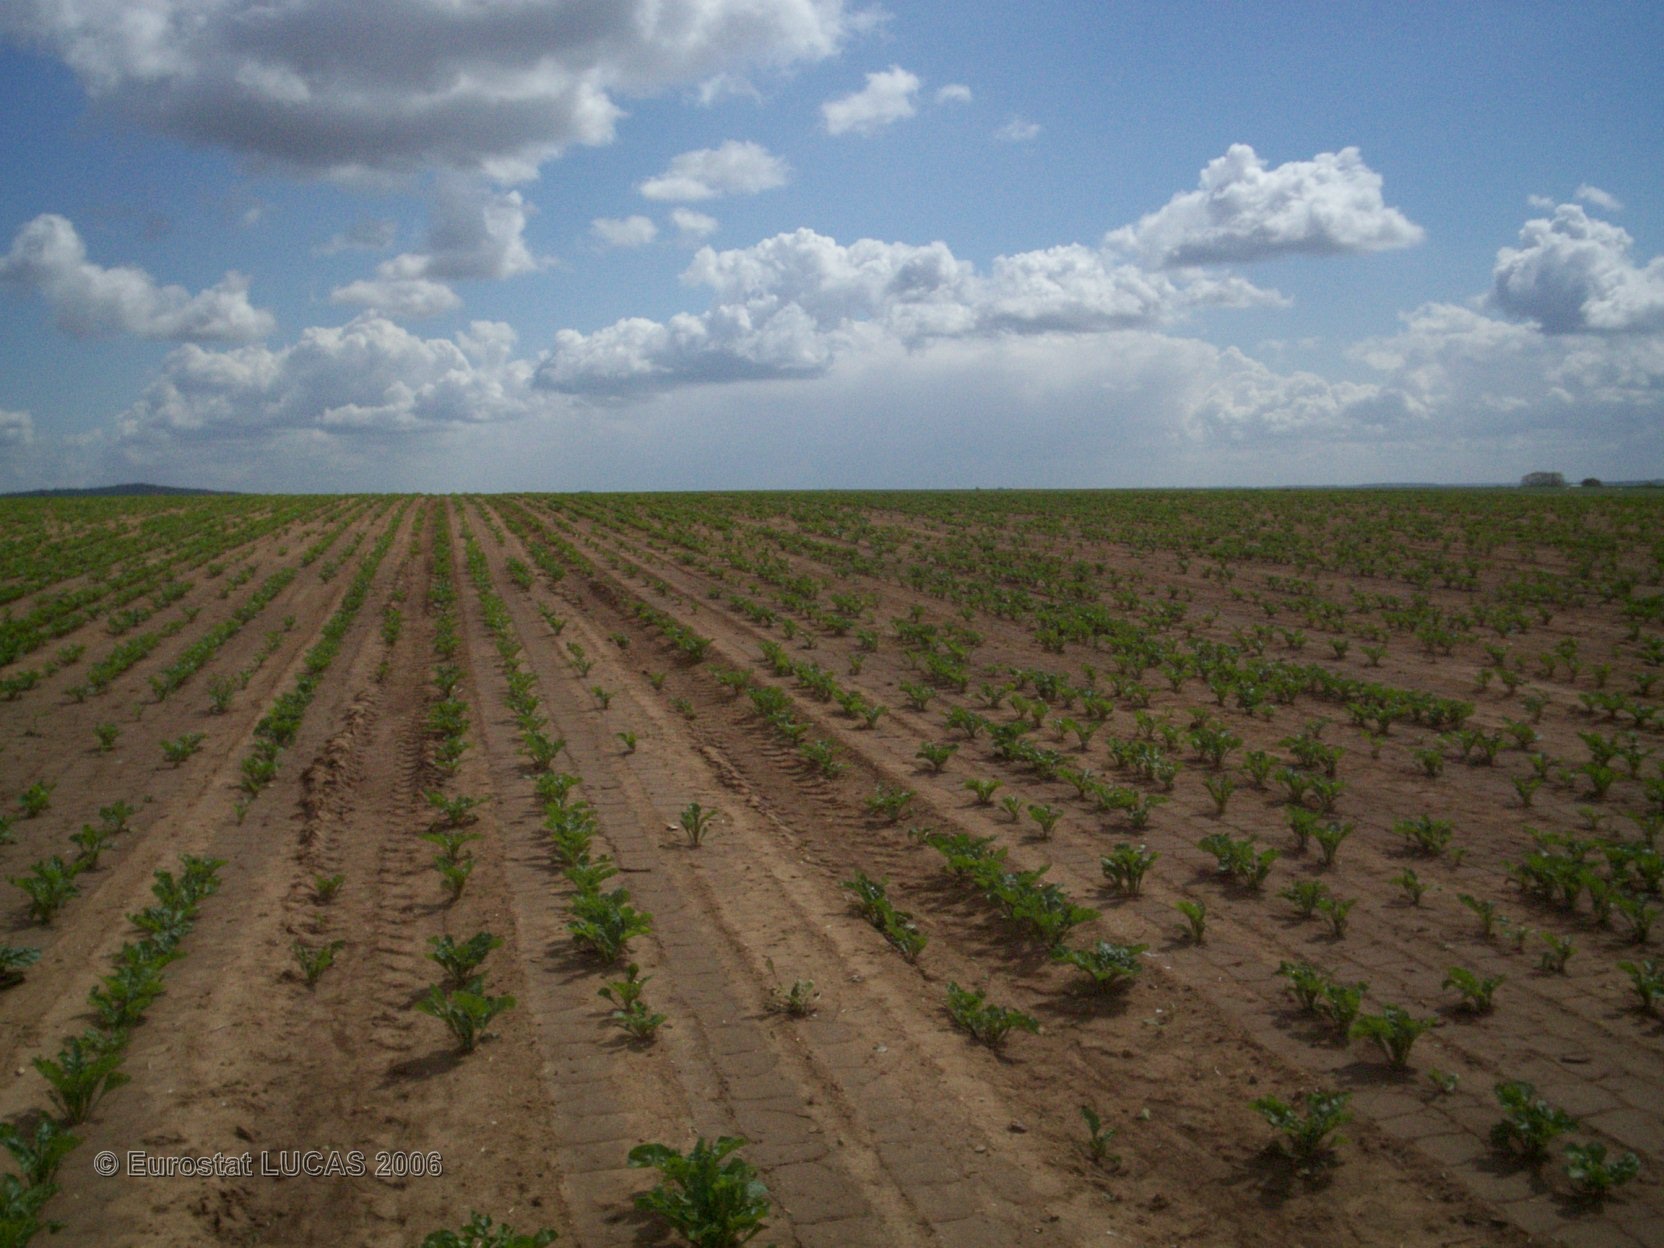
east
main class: Cropland
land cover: Sugar beet
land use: Agriculture (excluding fallow land and kitchen gardens)
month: May
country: FR
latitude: 48.9611
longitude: 2.7648
